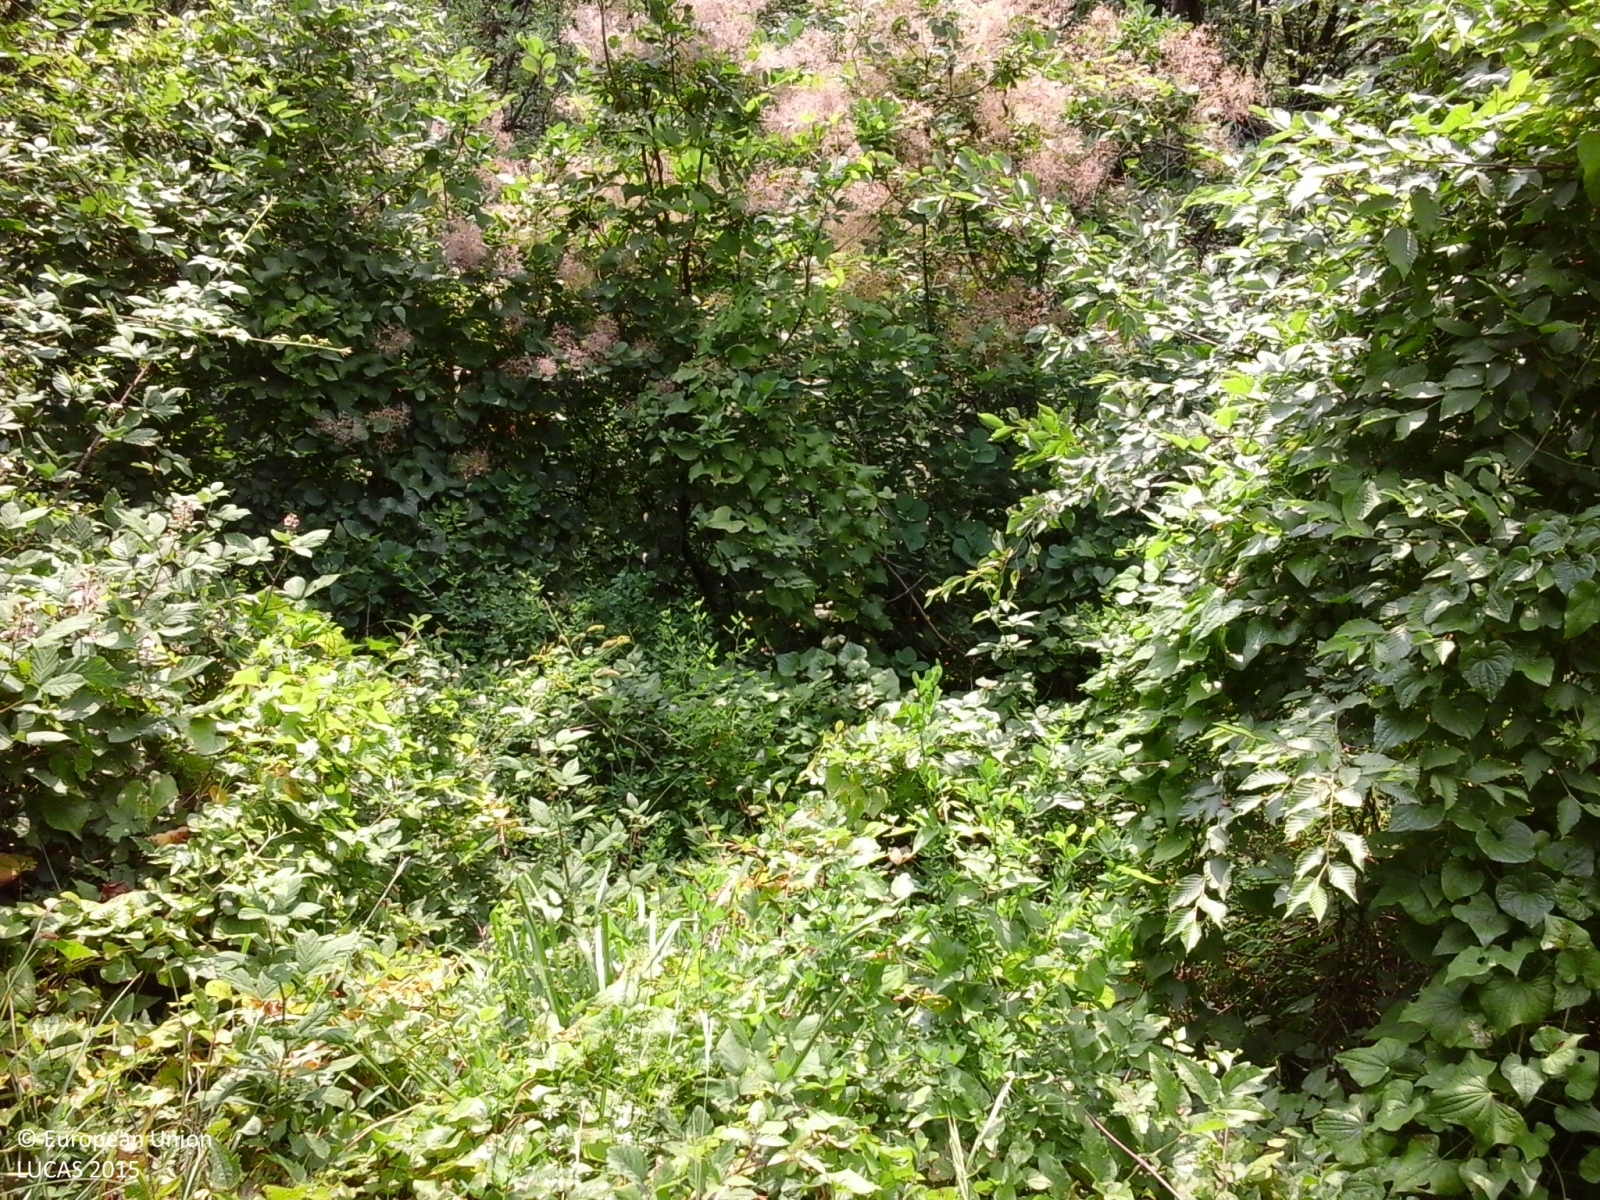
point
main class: Woodland
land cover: Broadleaved woodland
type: thermophilous deciduous forest
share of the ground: > 75 %
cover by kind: broadleaved forest trees 100 %
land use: Semi-natural and natural areas not in use
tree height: > 5 m
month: June
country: IT
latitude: 45.5400
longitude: 10.2941
